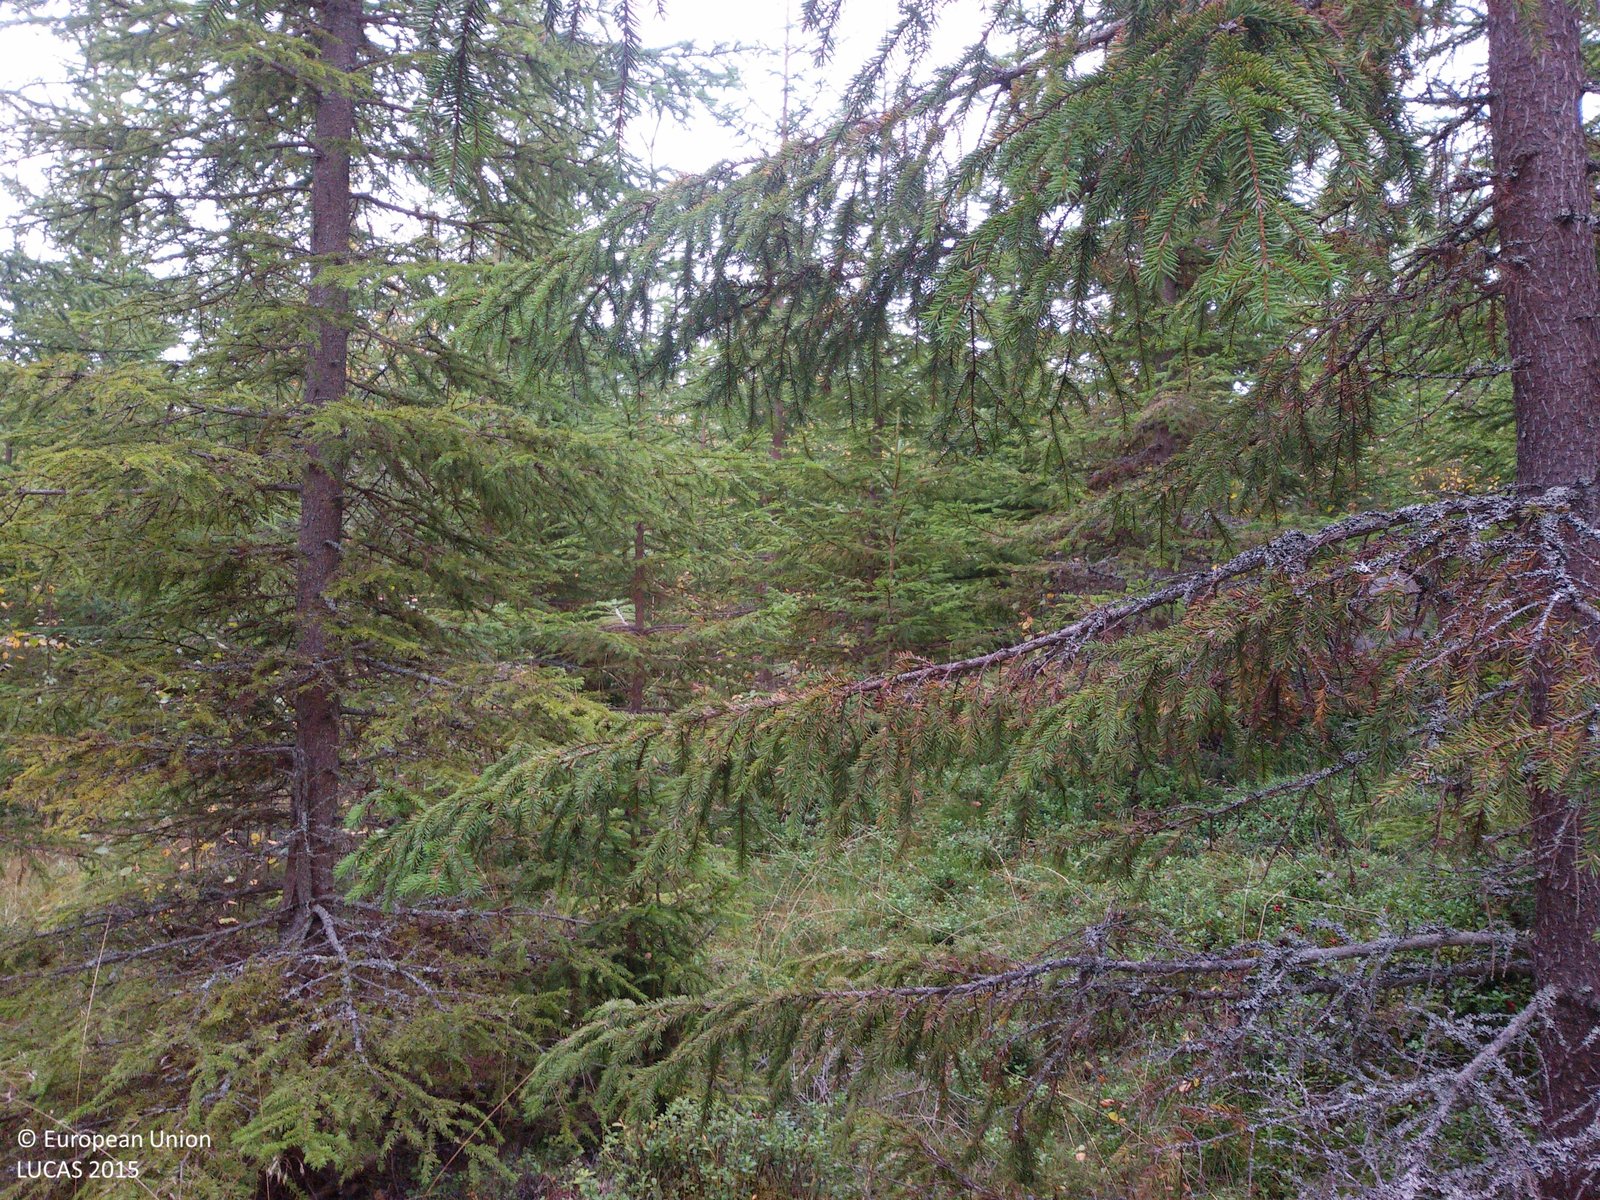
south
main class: Woodland
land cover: Spruce dominated coniferous woodland
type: boreal forest
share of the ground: 50 - 75 %
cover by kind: coniferous forest trees 70 %, lichens and mosses 15 %, shrubs 10 %, herbaceous plants 5 %
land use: Forestry
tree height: > 5 m
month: September
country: SE
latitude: 60.6880
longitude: 14.9863
